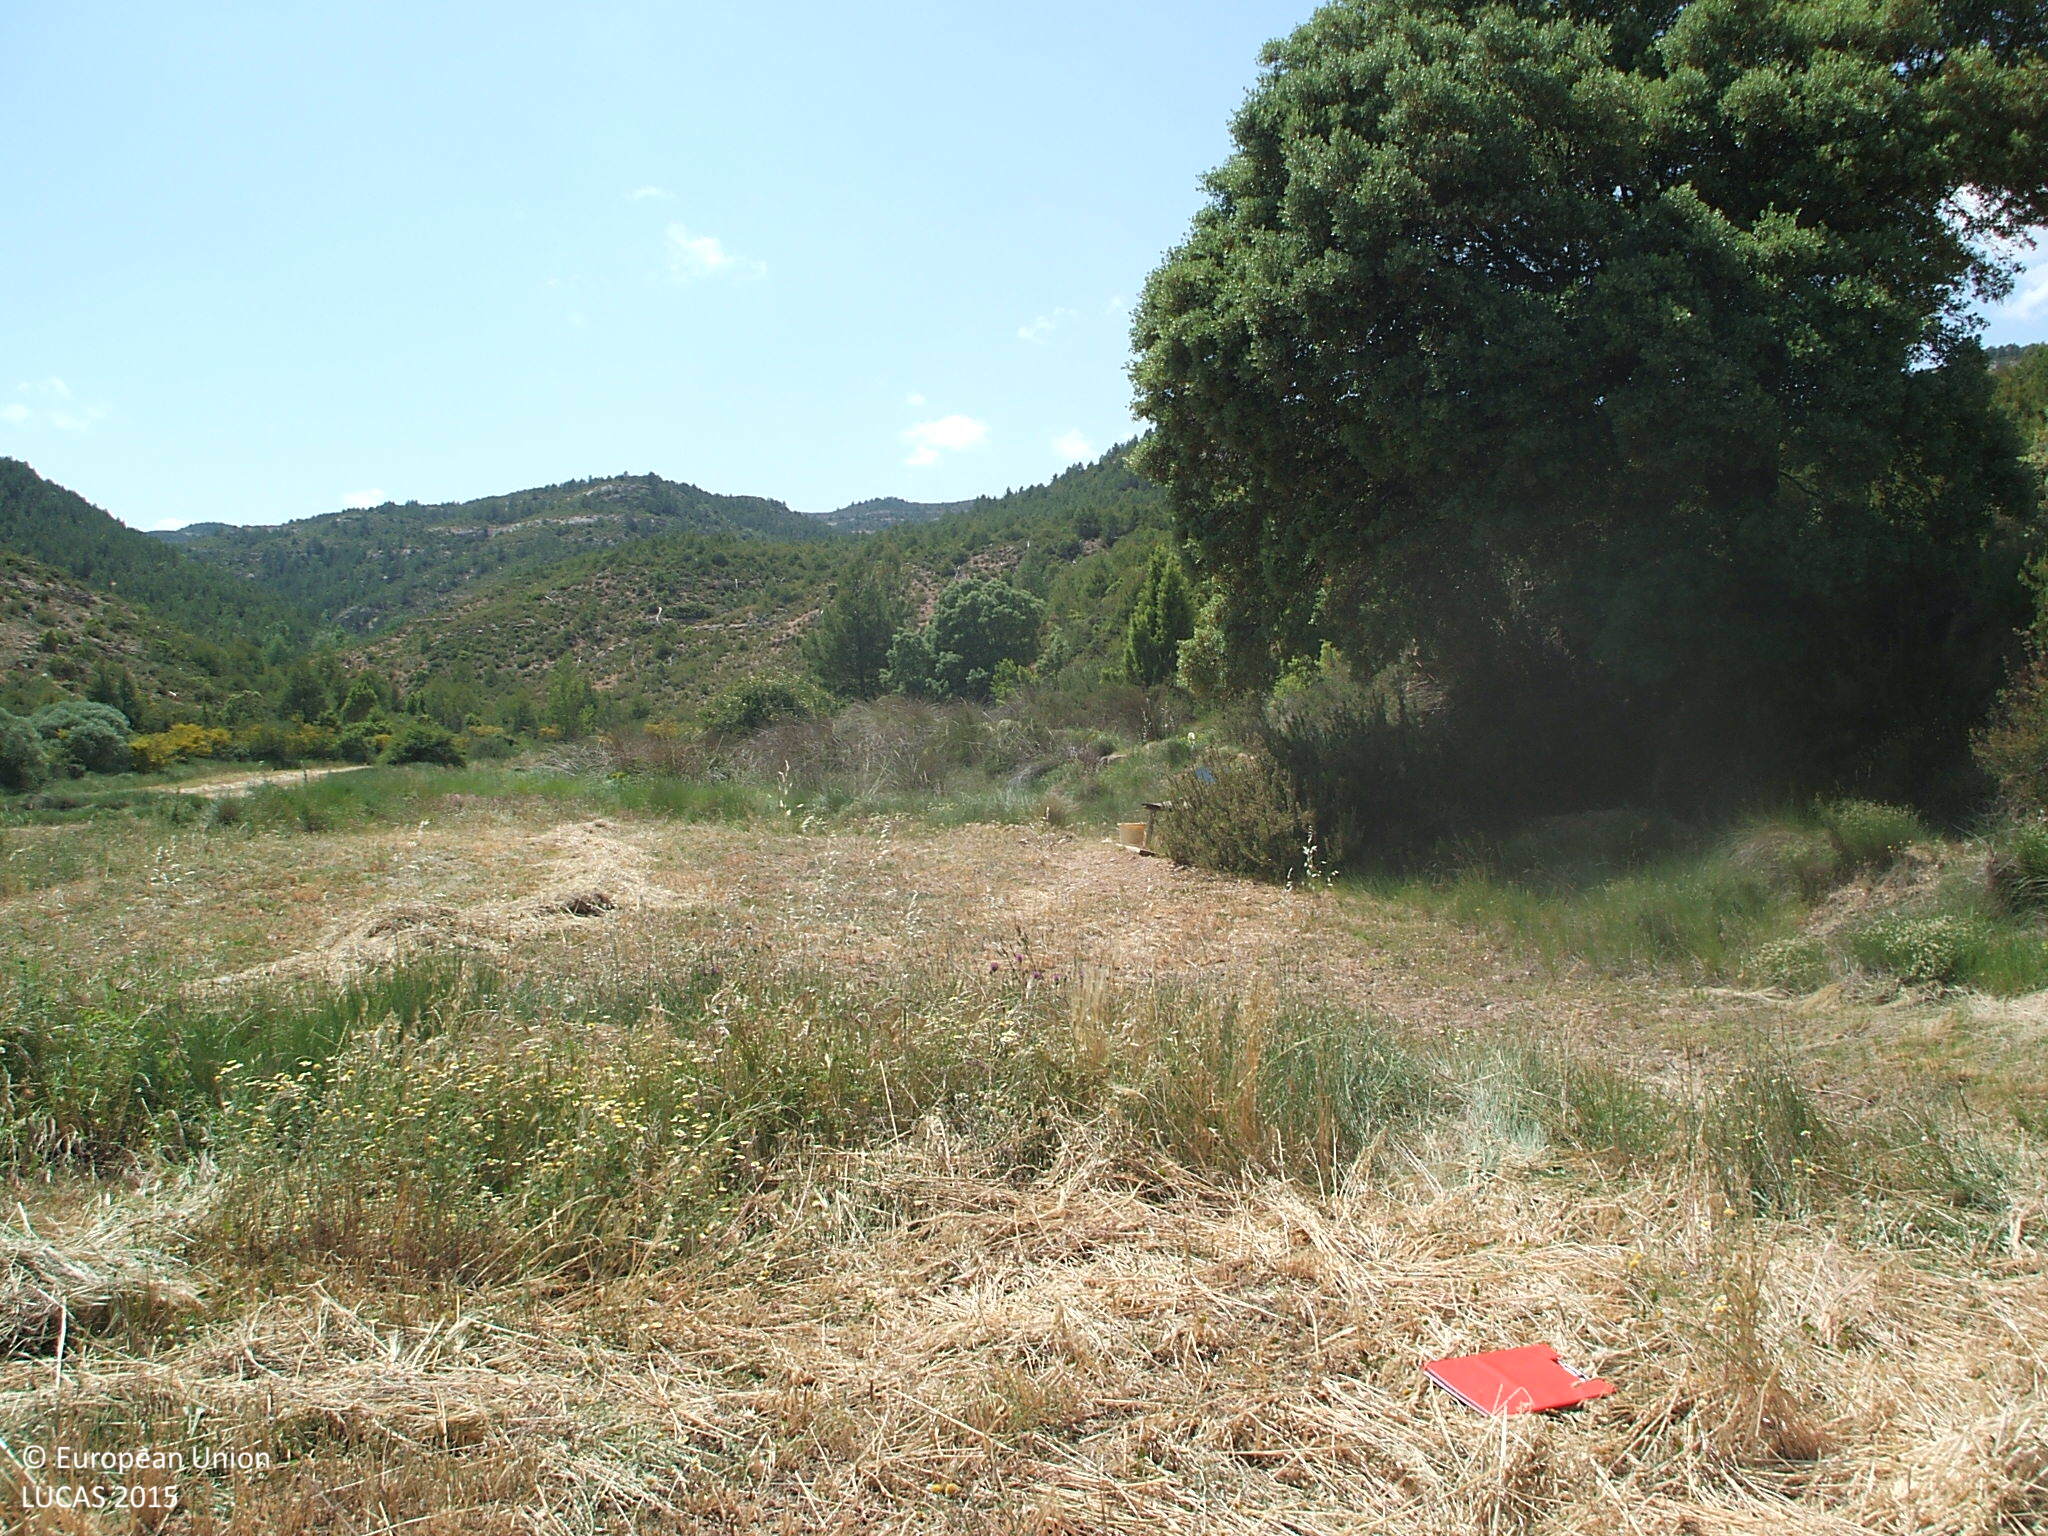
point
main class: Cropland
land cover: Oats
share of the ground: < 10 %
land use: Agriculture (excluding fallow land and kitchen gardens)
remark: Harvested field
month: May
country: ES
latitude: 40.7180
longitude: -0.2014
